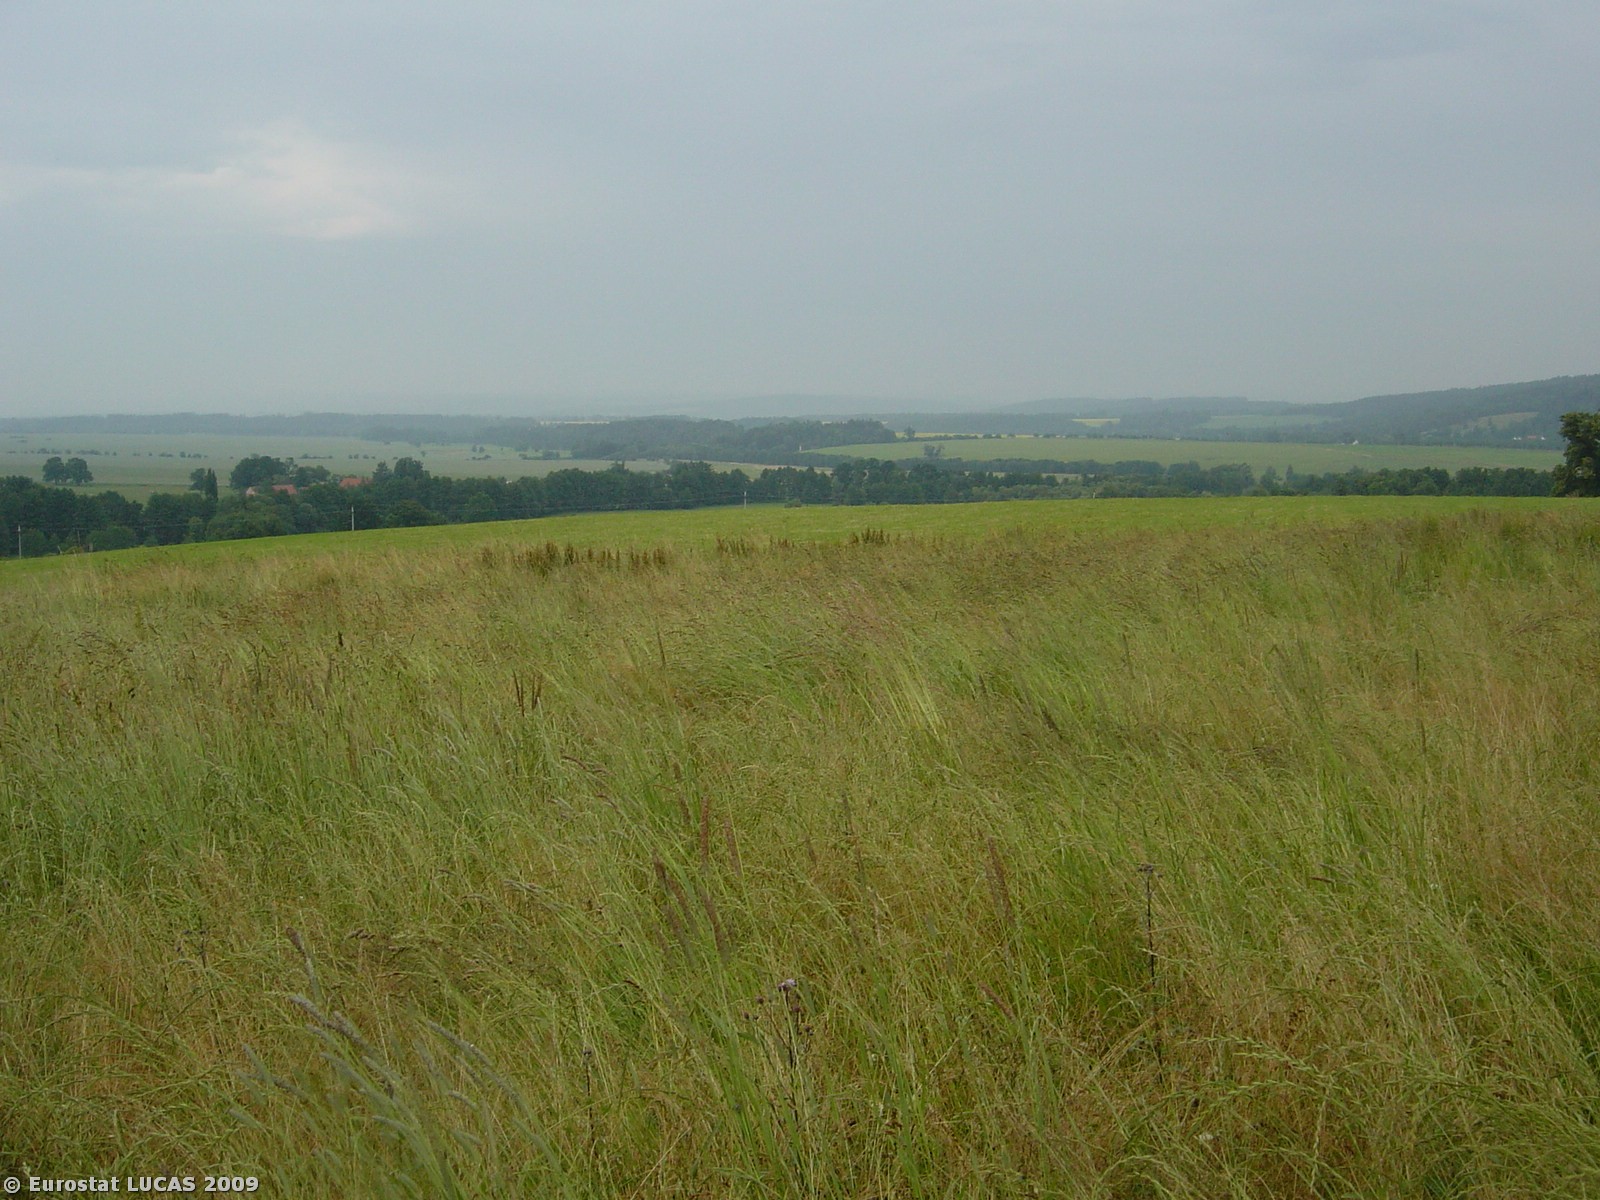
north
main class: Grassland
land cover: Grassland without tree/shrub cover
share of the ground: > 75 %
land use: Agriculture (excluding fallow land and kitchen gardens)
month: July
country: CZ
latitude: 50.0483
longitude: 12.5274
